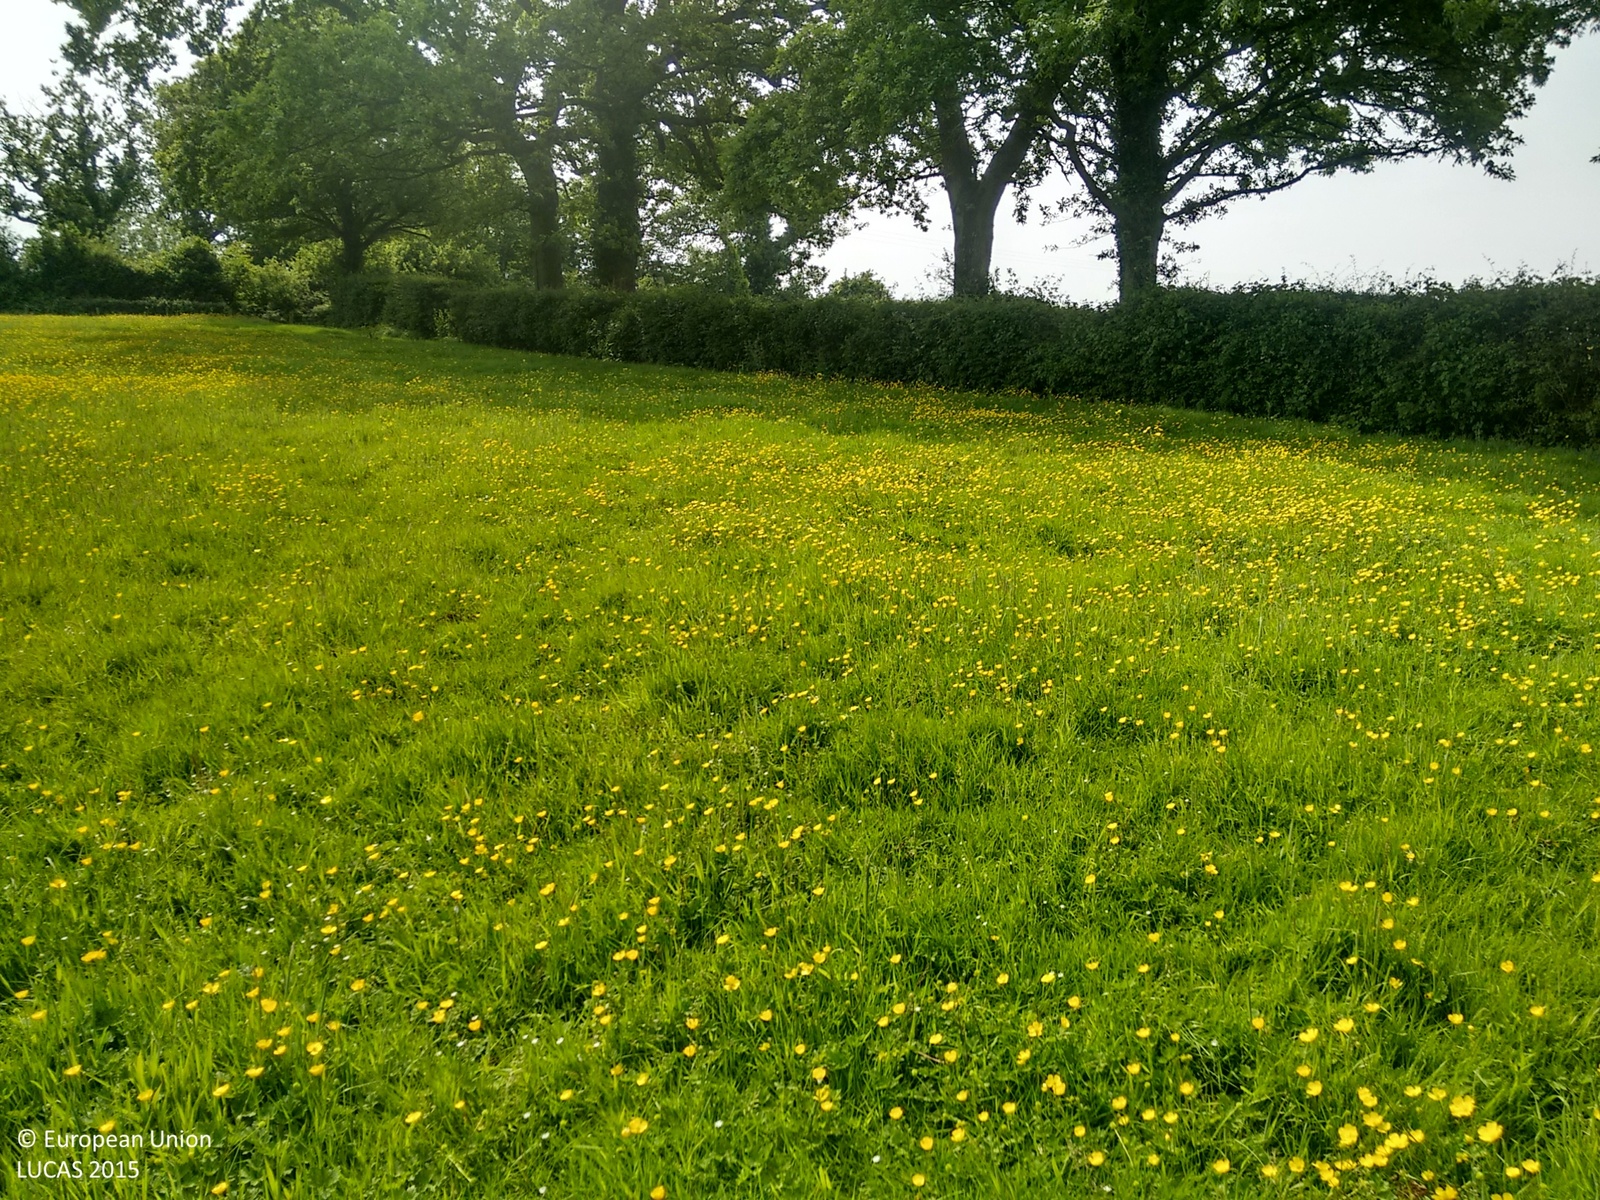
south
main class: Grassland
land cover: Grassland without tree/shrub cover
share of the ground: > 75 %
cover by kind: herbaceous plants 100 %
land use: Agriculture (excluding fallow land and kitchen gardens)
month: June
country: GB
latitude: 51.0365
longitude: 0.2869
